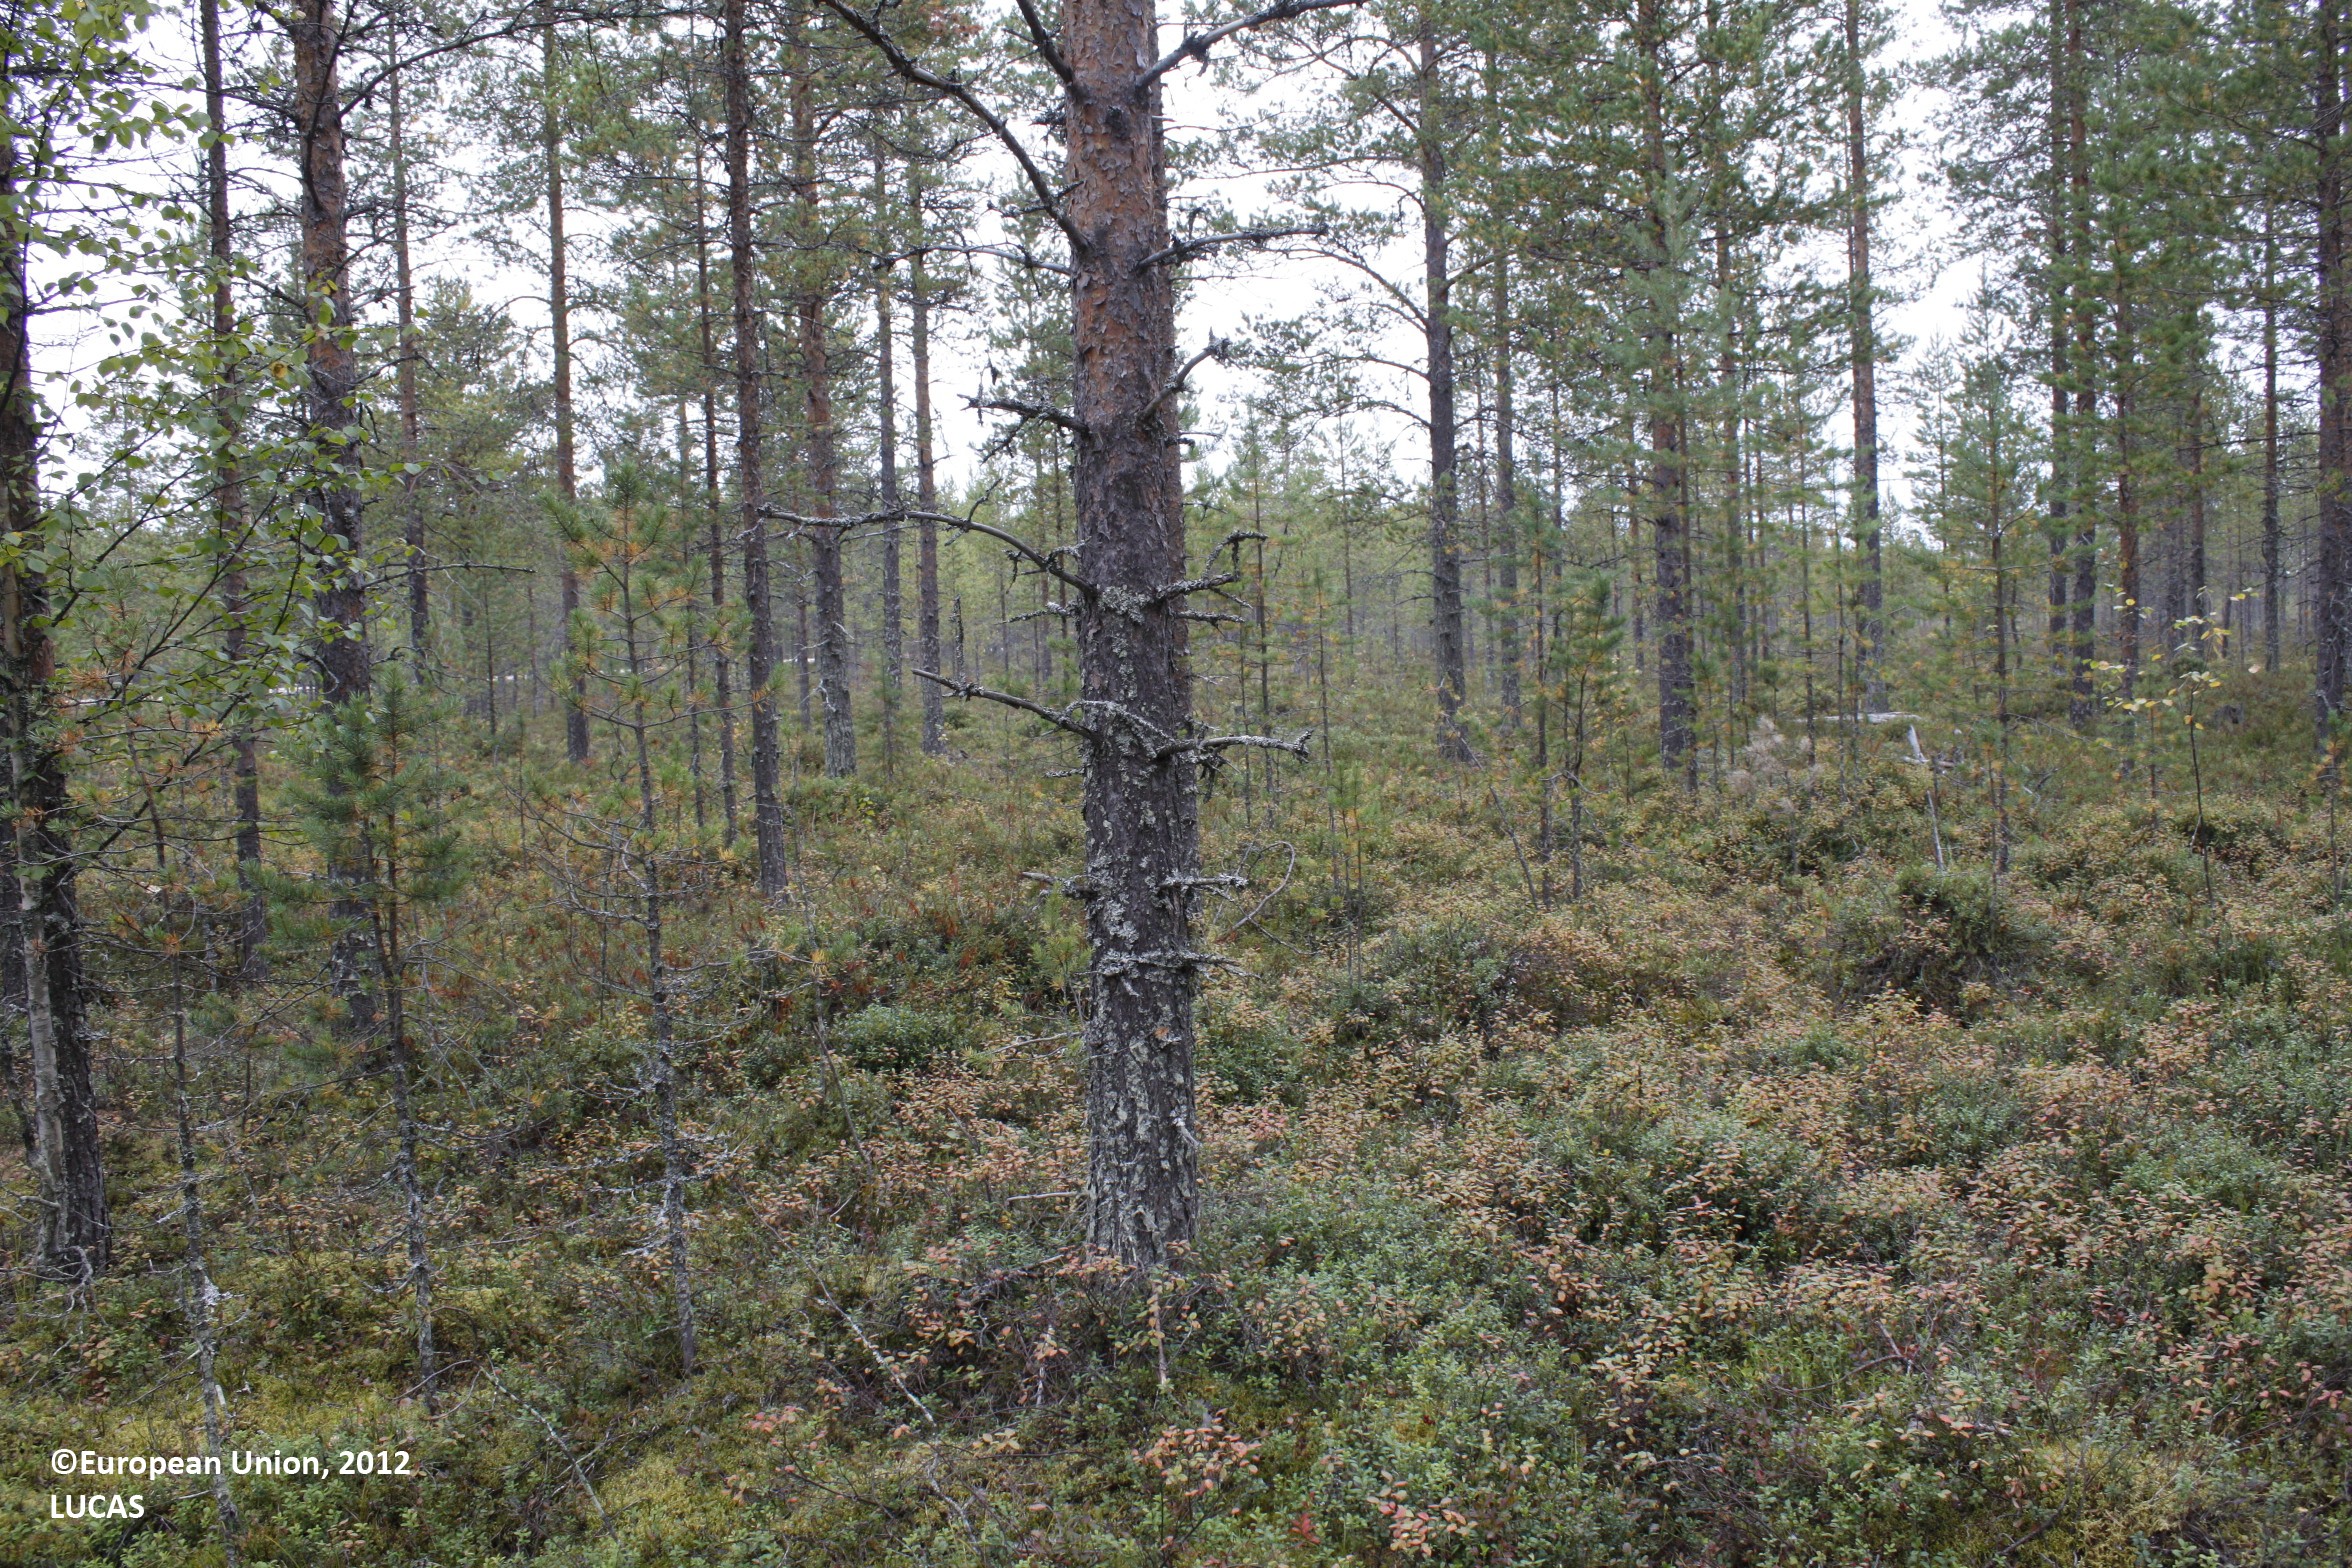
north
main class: Woodland
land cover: Pine dominated coniferous woodland
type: mire and swamp forests
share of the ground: 25 - 50 %
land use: Forestry
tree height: > 5 m
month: September
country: FI
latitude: 65.4316
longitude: 26.5499
